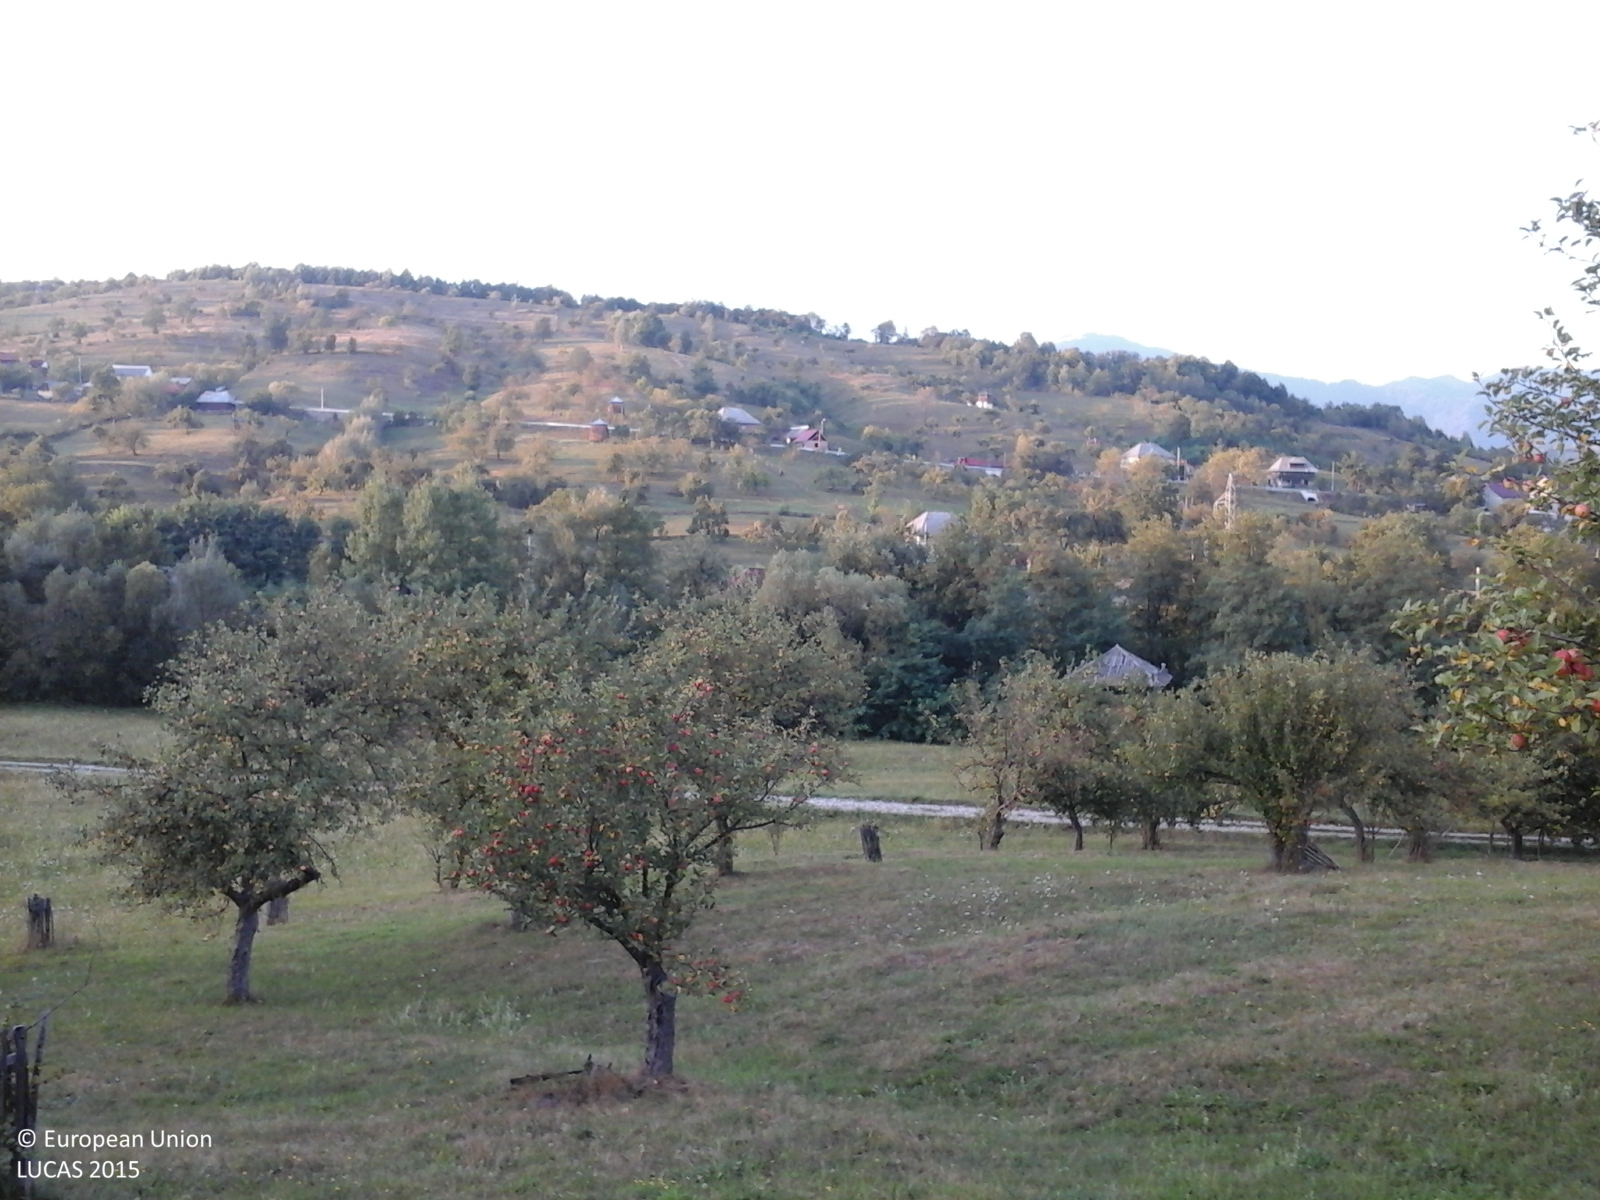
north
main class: Cropland
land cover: Apple fruit
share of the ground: 25 - 50 %
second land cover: Grassland without tree/shrub cover
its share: > 75 %
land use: Agriculture (excluding fallow land and kitchen gardens)
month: September
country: RO
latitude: 47.8305
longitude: 24.1826
